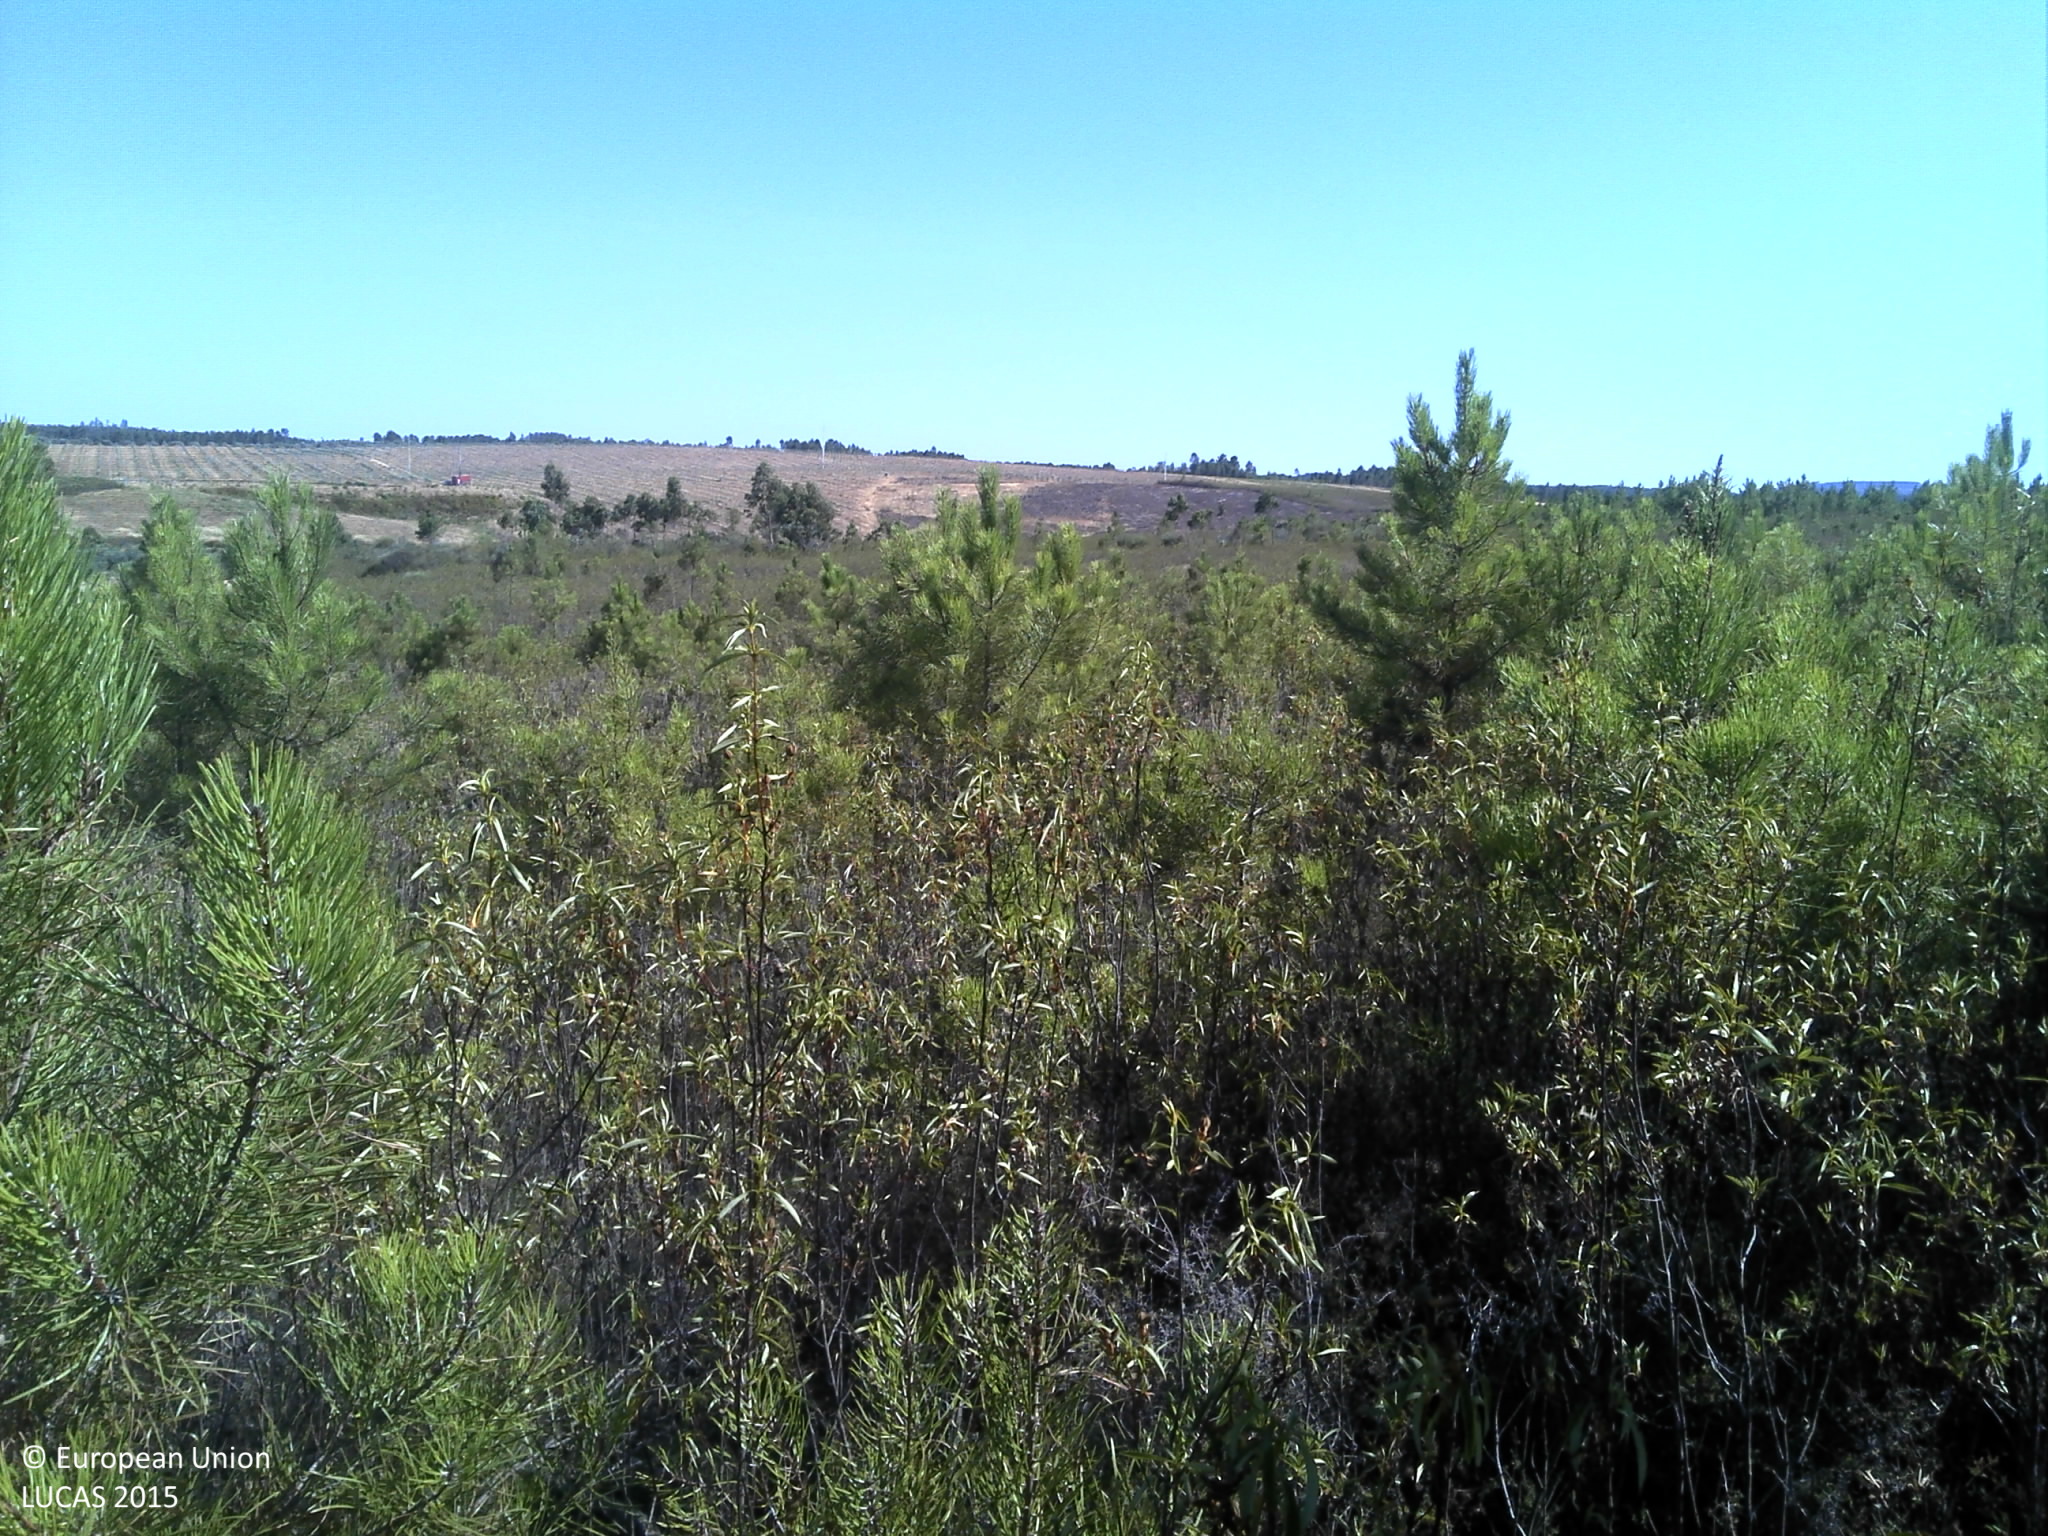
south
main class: Shrubland
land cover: Shrubland with sparse tree cover
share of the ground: 50 - 75 %
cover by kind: shrubs 70 %, unconsolidated bare surface 25 %, coniferous forest trees 5 %
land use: Forestry
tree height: < 5 m
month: July
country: PT
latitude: 39.9280
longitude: -7.6444
